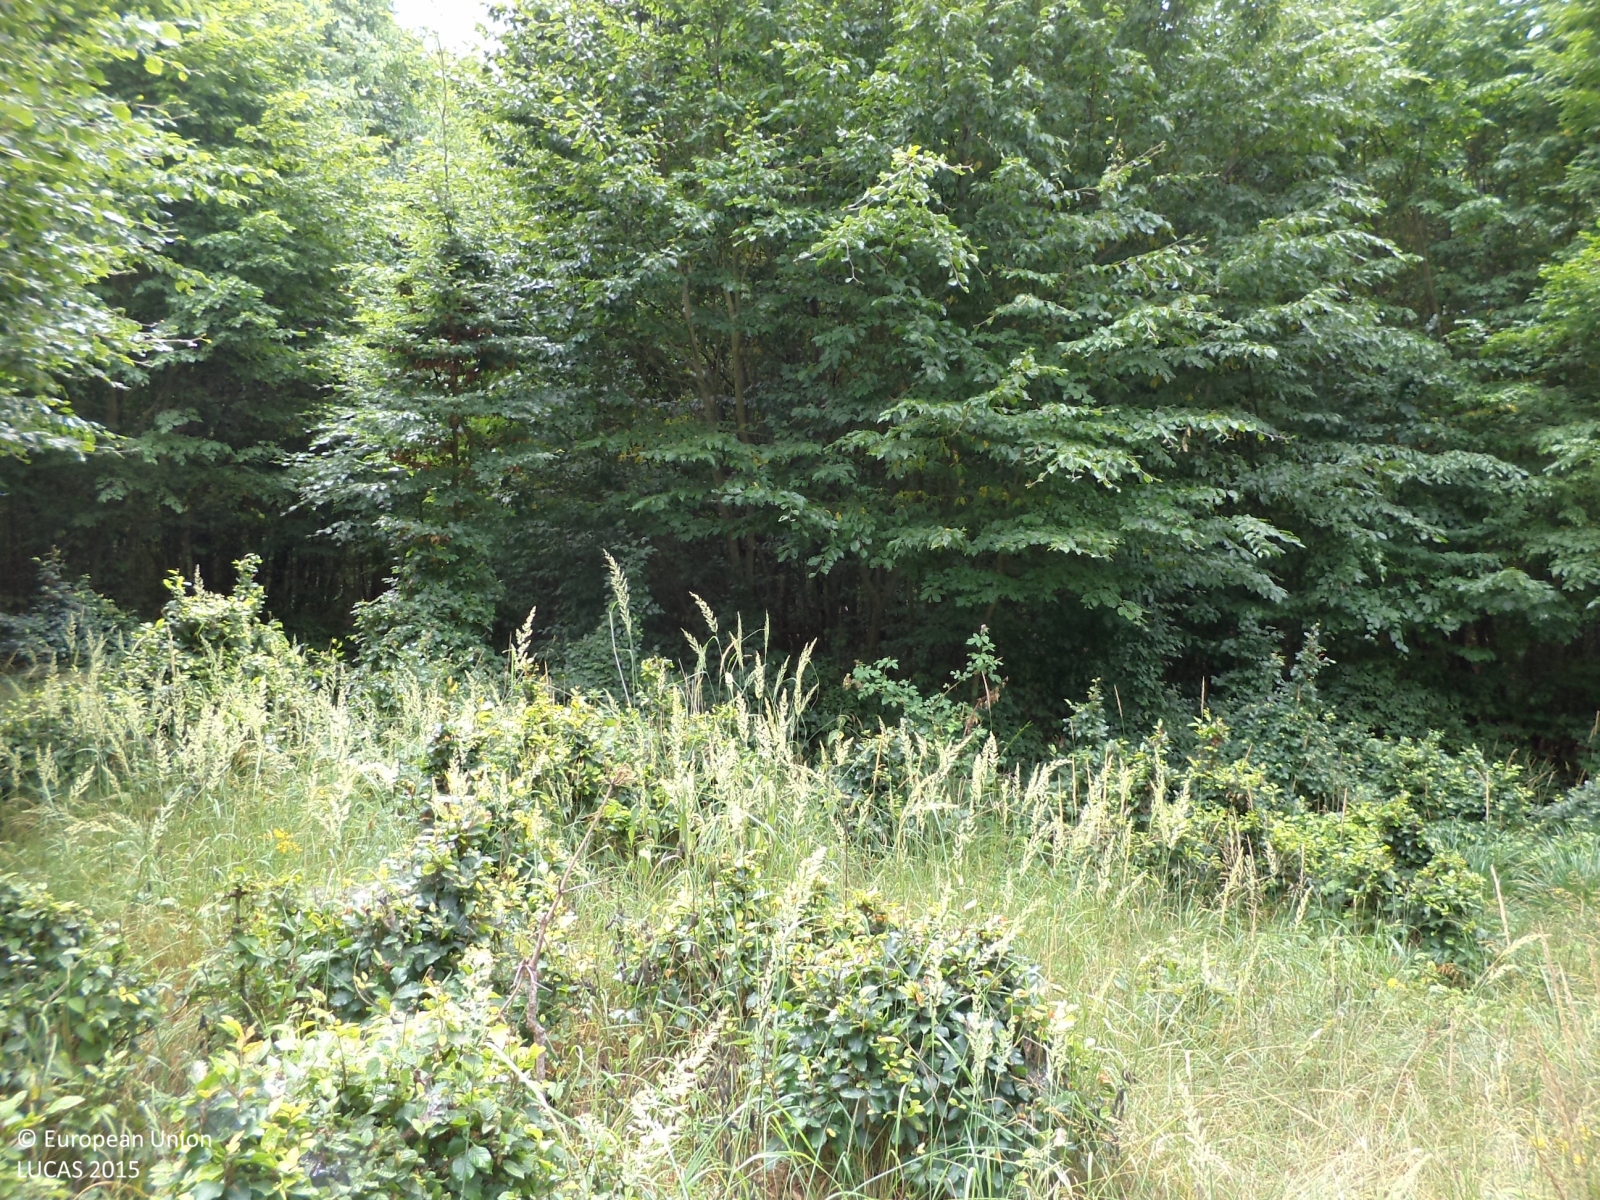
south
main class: Woodland
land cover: Broadleaved woodland
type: beech forest
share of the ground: > 75 %
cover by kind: broadleaved forest trees 80 %, shrubs 10 %, herbaceous plants 10 %
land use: Forestry
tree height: > 5 m
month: July
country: CZ
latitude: 50.0238
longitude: 14.0069
